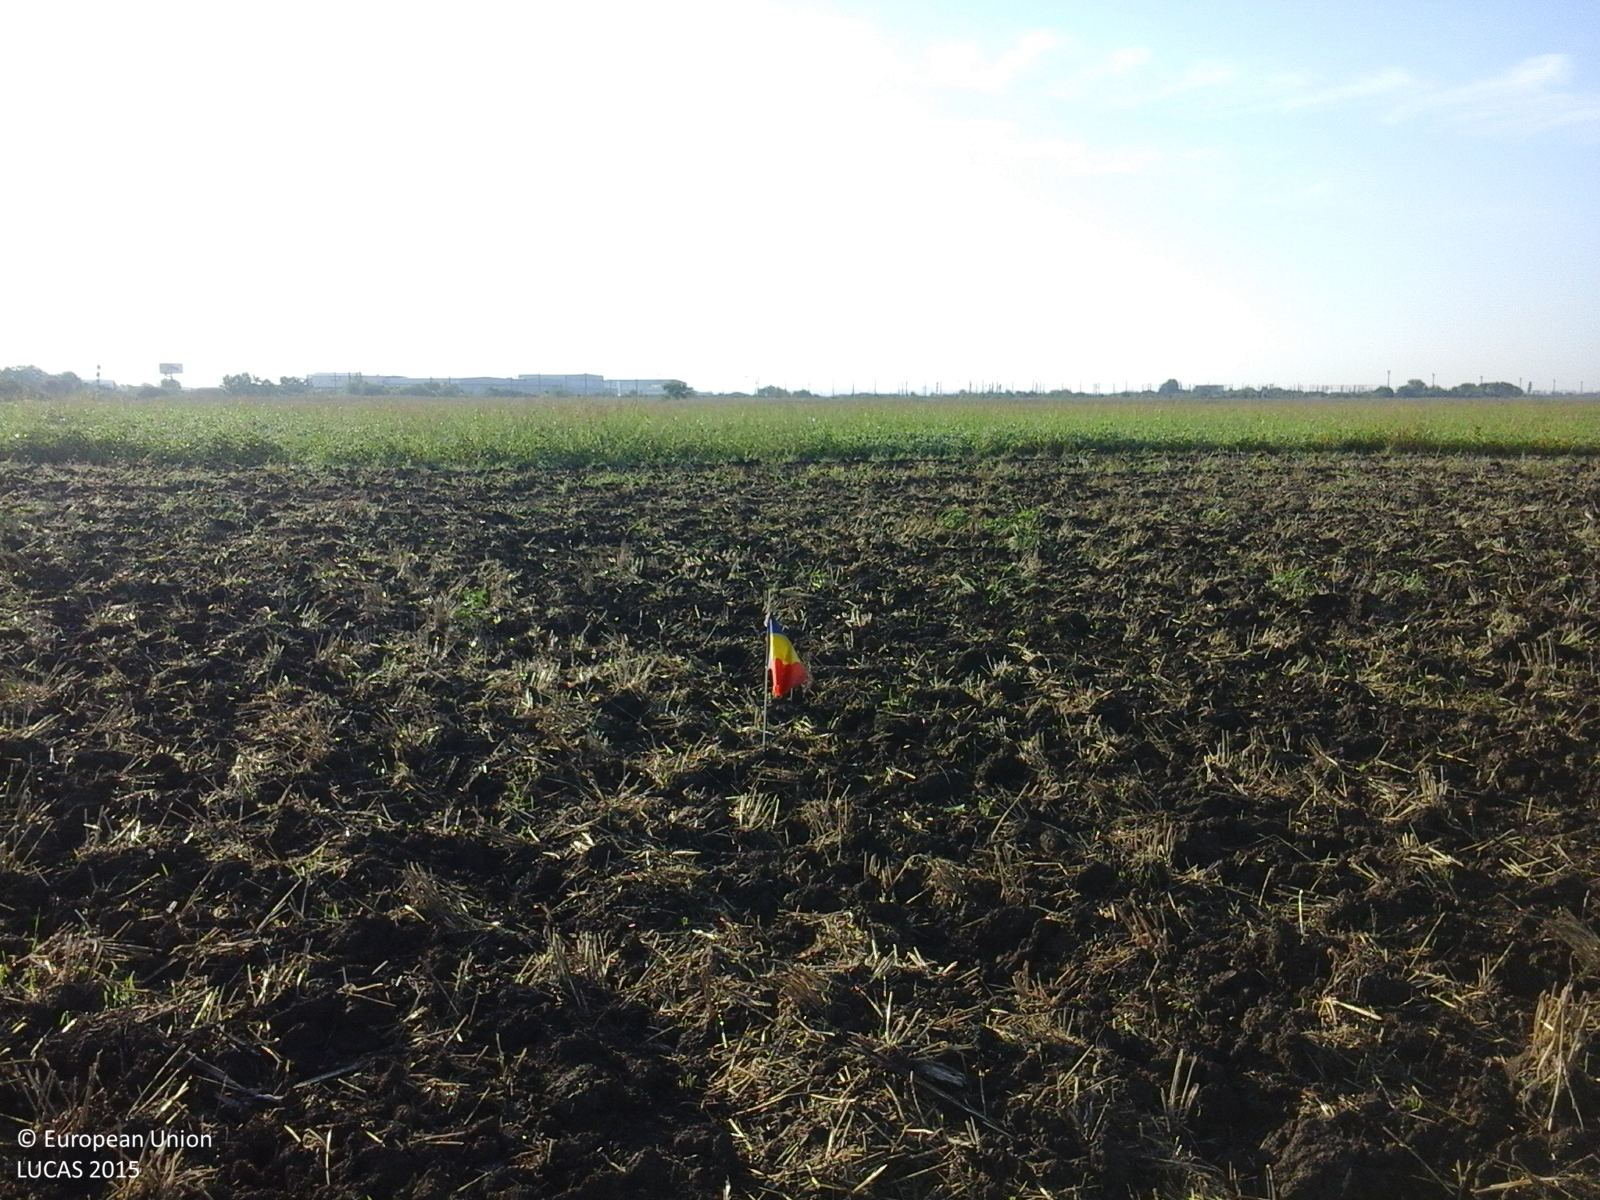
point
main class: Cropland
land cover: Common wheat
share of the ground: 25 - 50 %
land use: Agriculture (excluding fallow land and kitchen gardens)
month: August
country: RO
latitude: 45.8017
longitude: 21.1596
